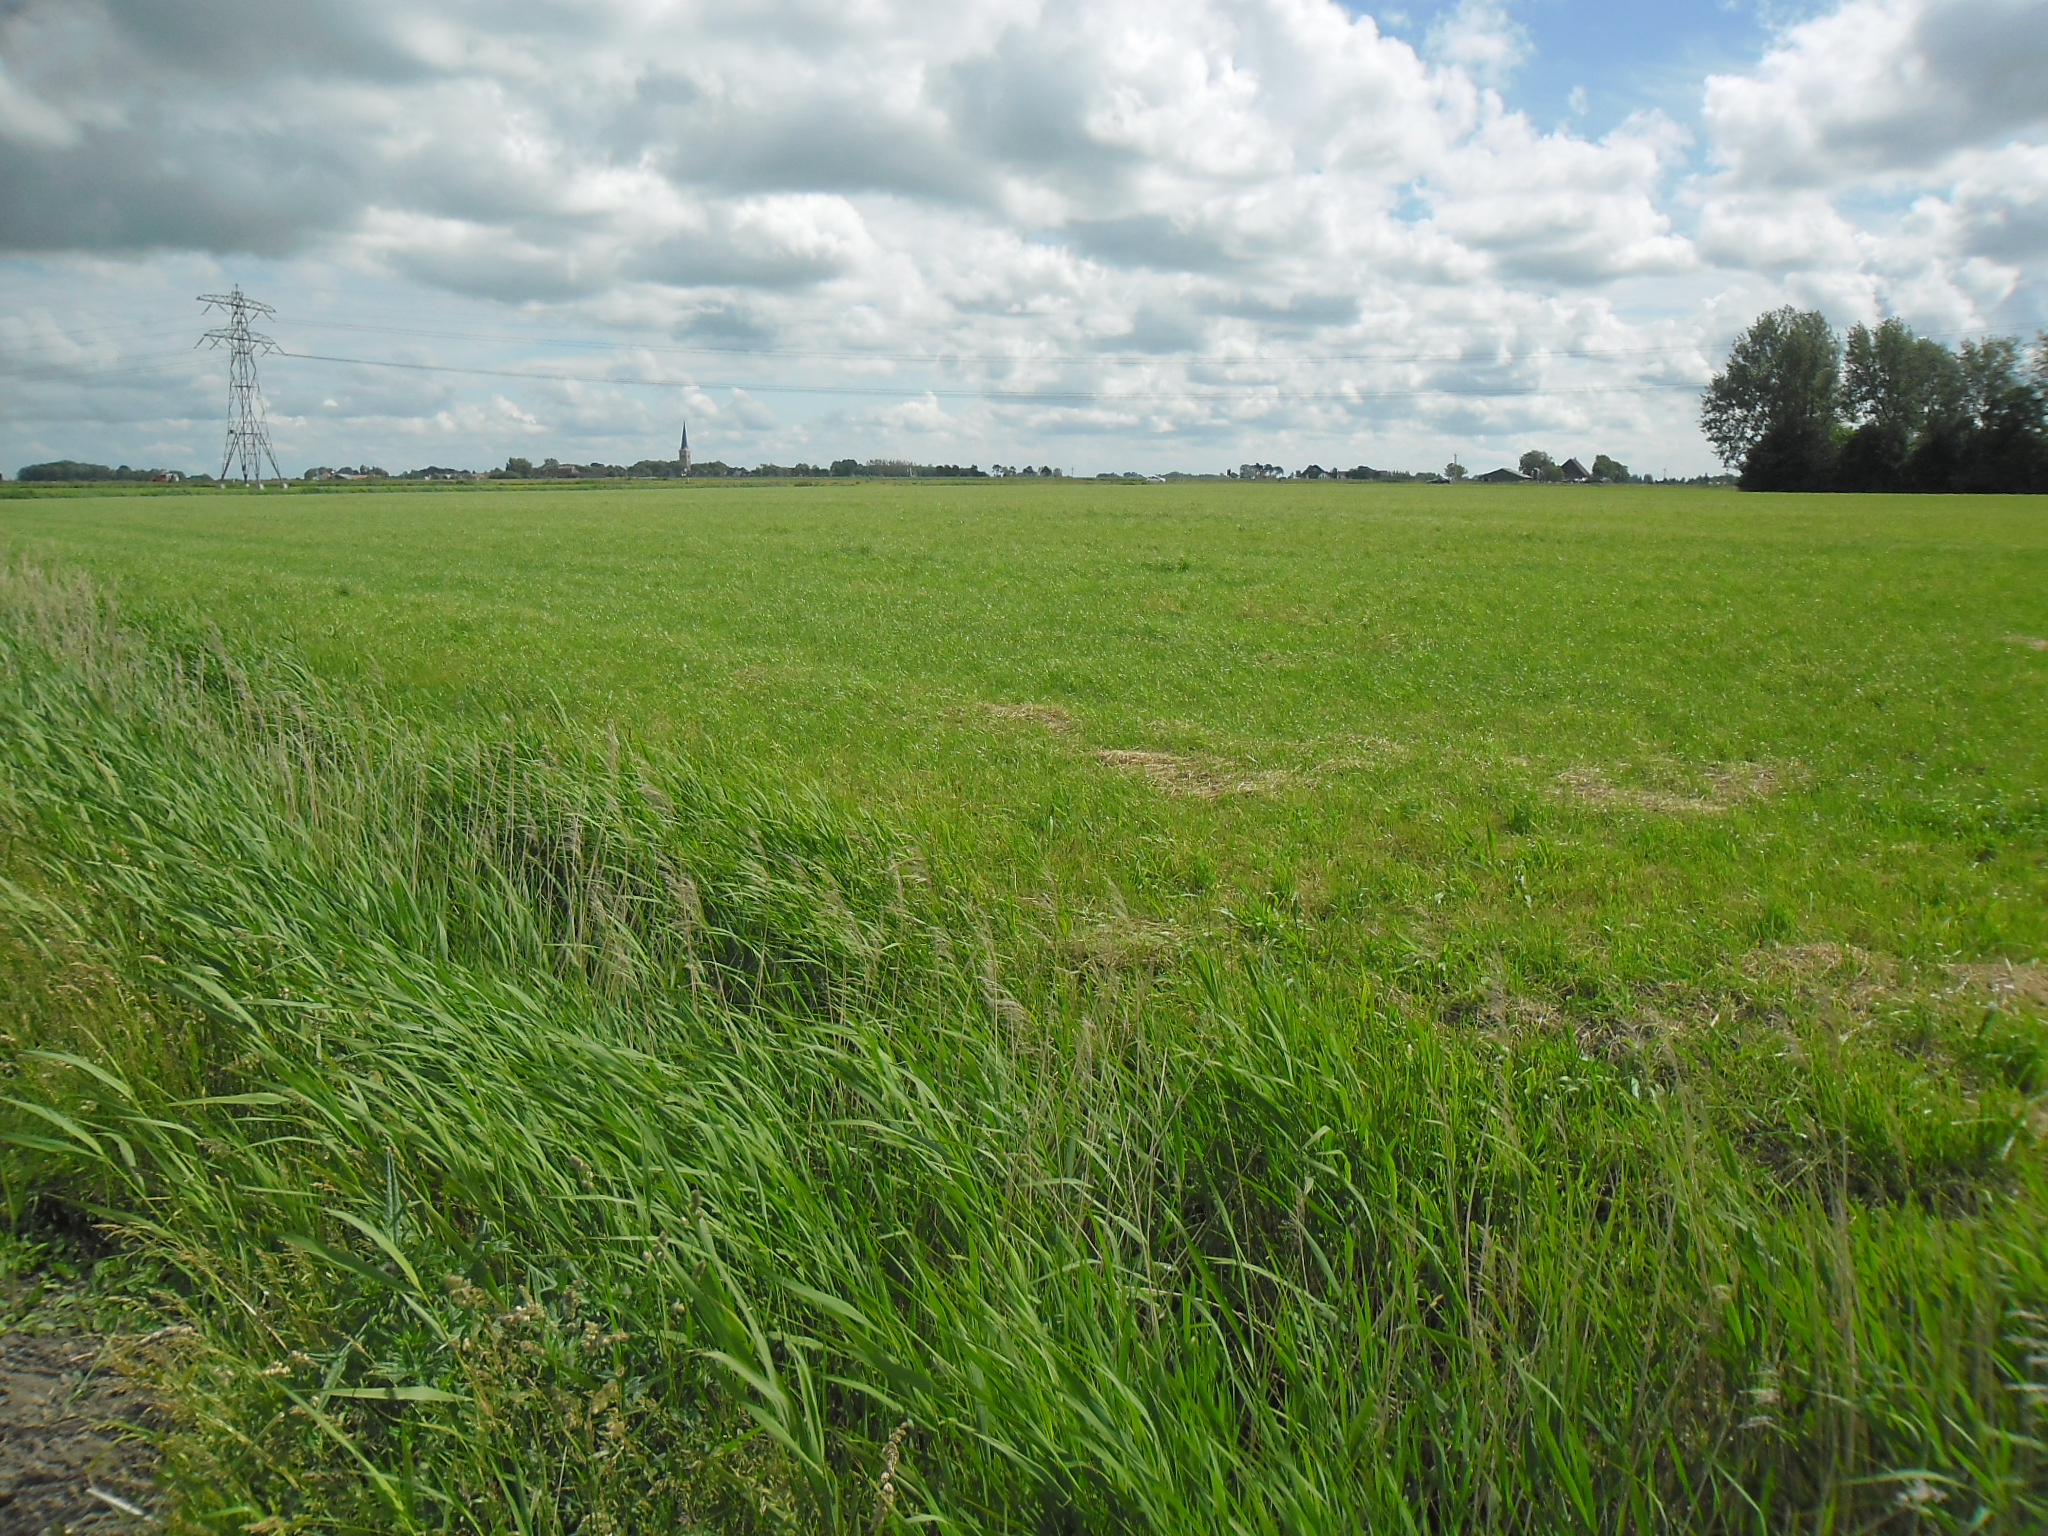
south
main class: Cropland
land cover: Maize
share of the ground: 10 - 25 %
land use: Agriculture (excluding fallow land and kitchen gardens)
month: June
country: NL
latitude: 53.1764
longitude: 5.5552
